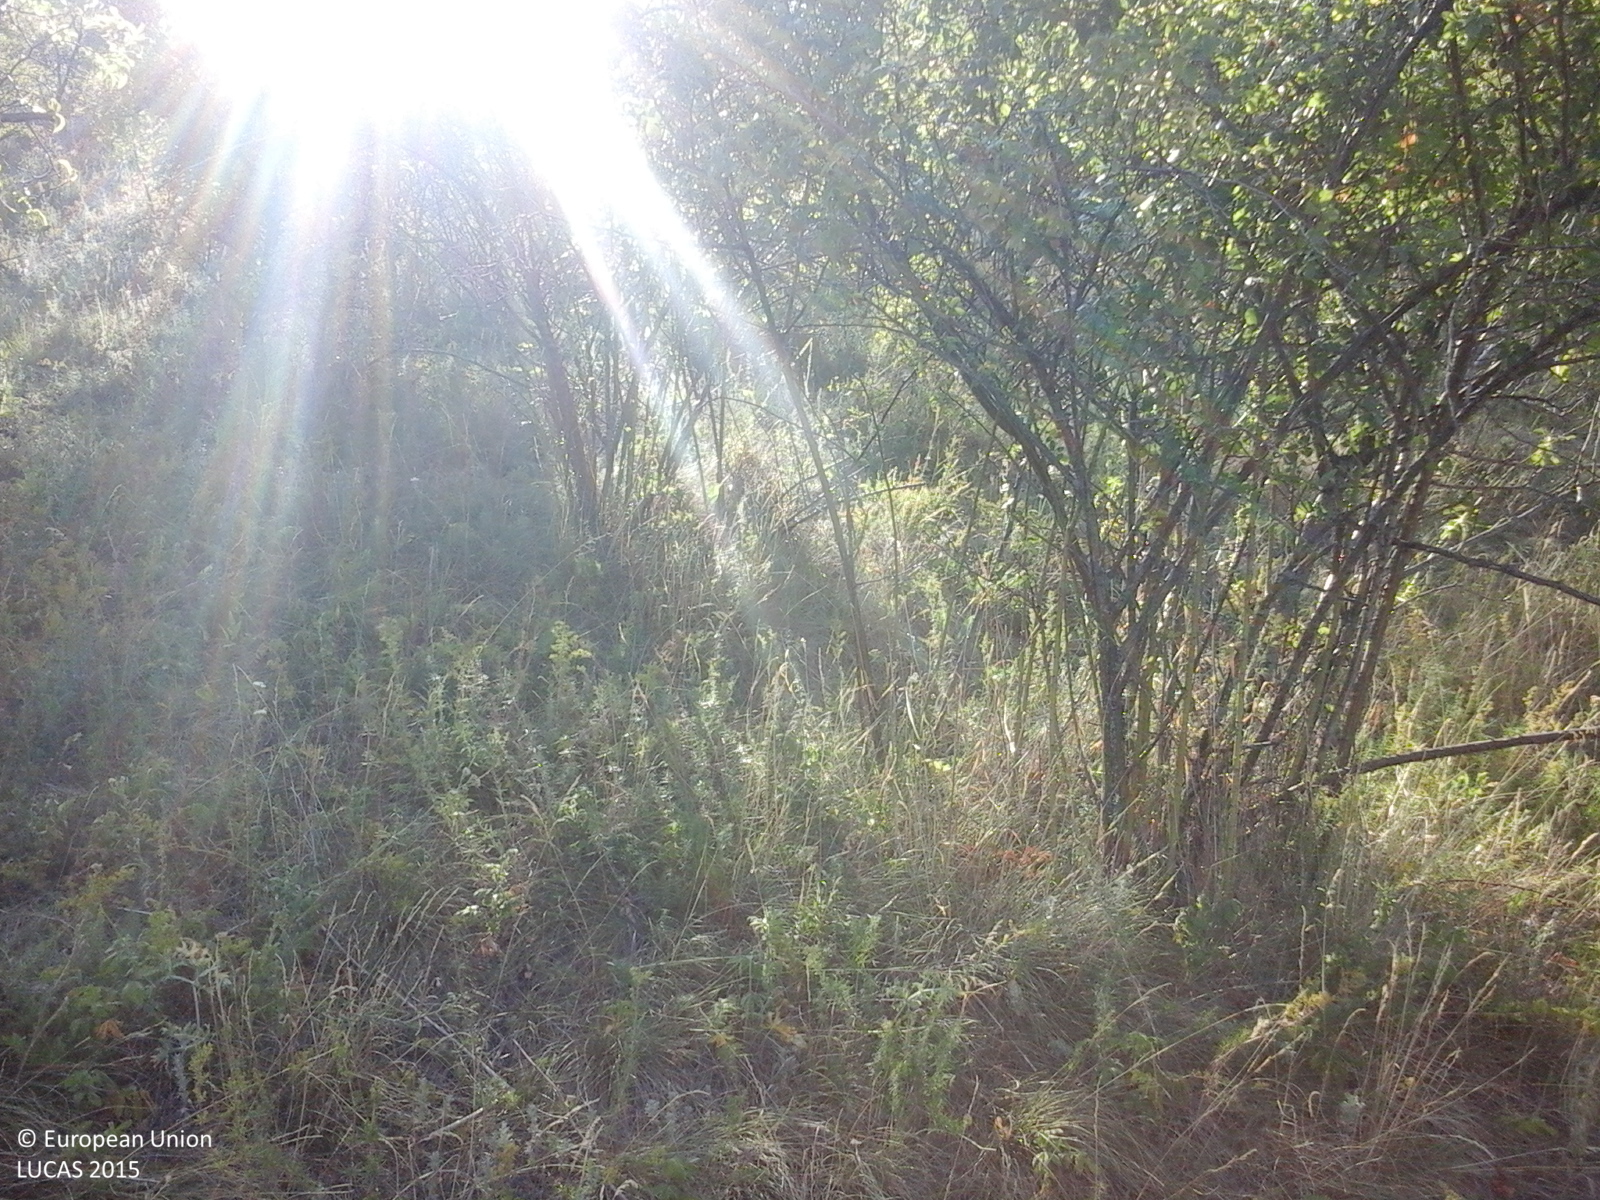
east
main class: Shrubland
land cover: Shrubland with sparse tree cover
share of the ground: > 75 %
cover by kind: herbaceous plants 75 %, shrubs 20 %, broadleaved forest trees 5 %
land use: Semi-natural and natural areas not in use
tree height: > 5 m
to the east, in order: Shrubland with sparse tree cover; Grassland with sparse tree/shrub cover
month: July
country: RO
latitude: 46.5628
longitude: 27.2047
